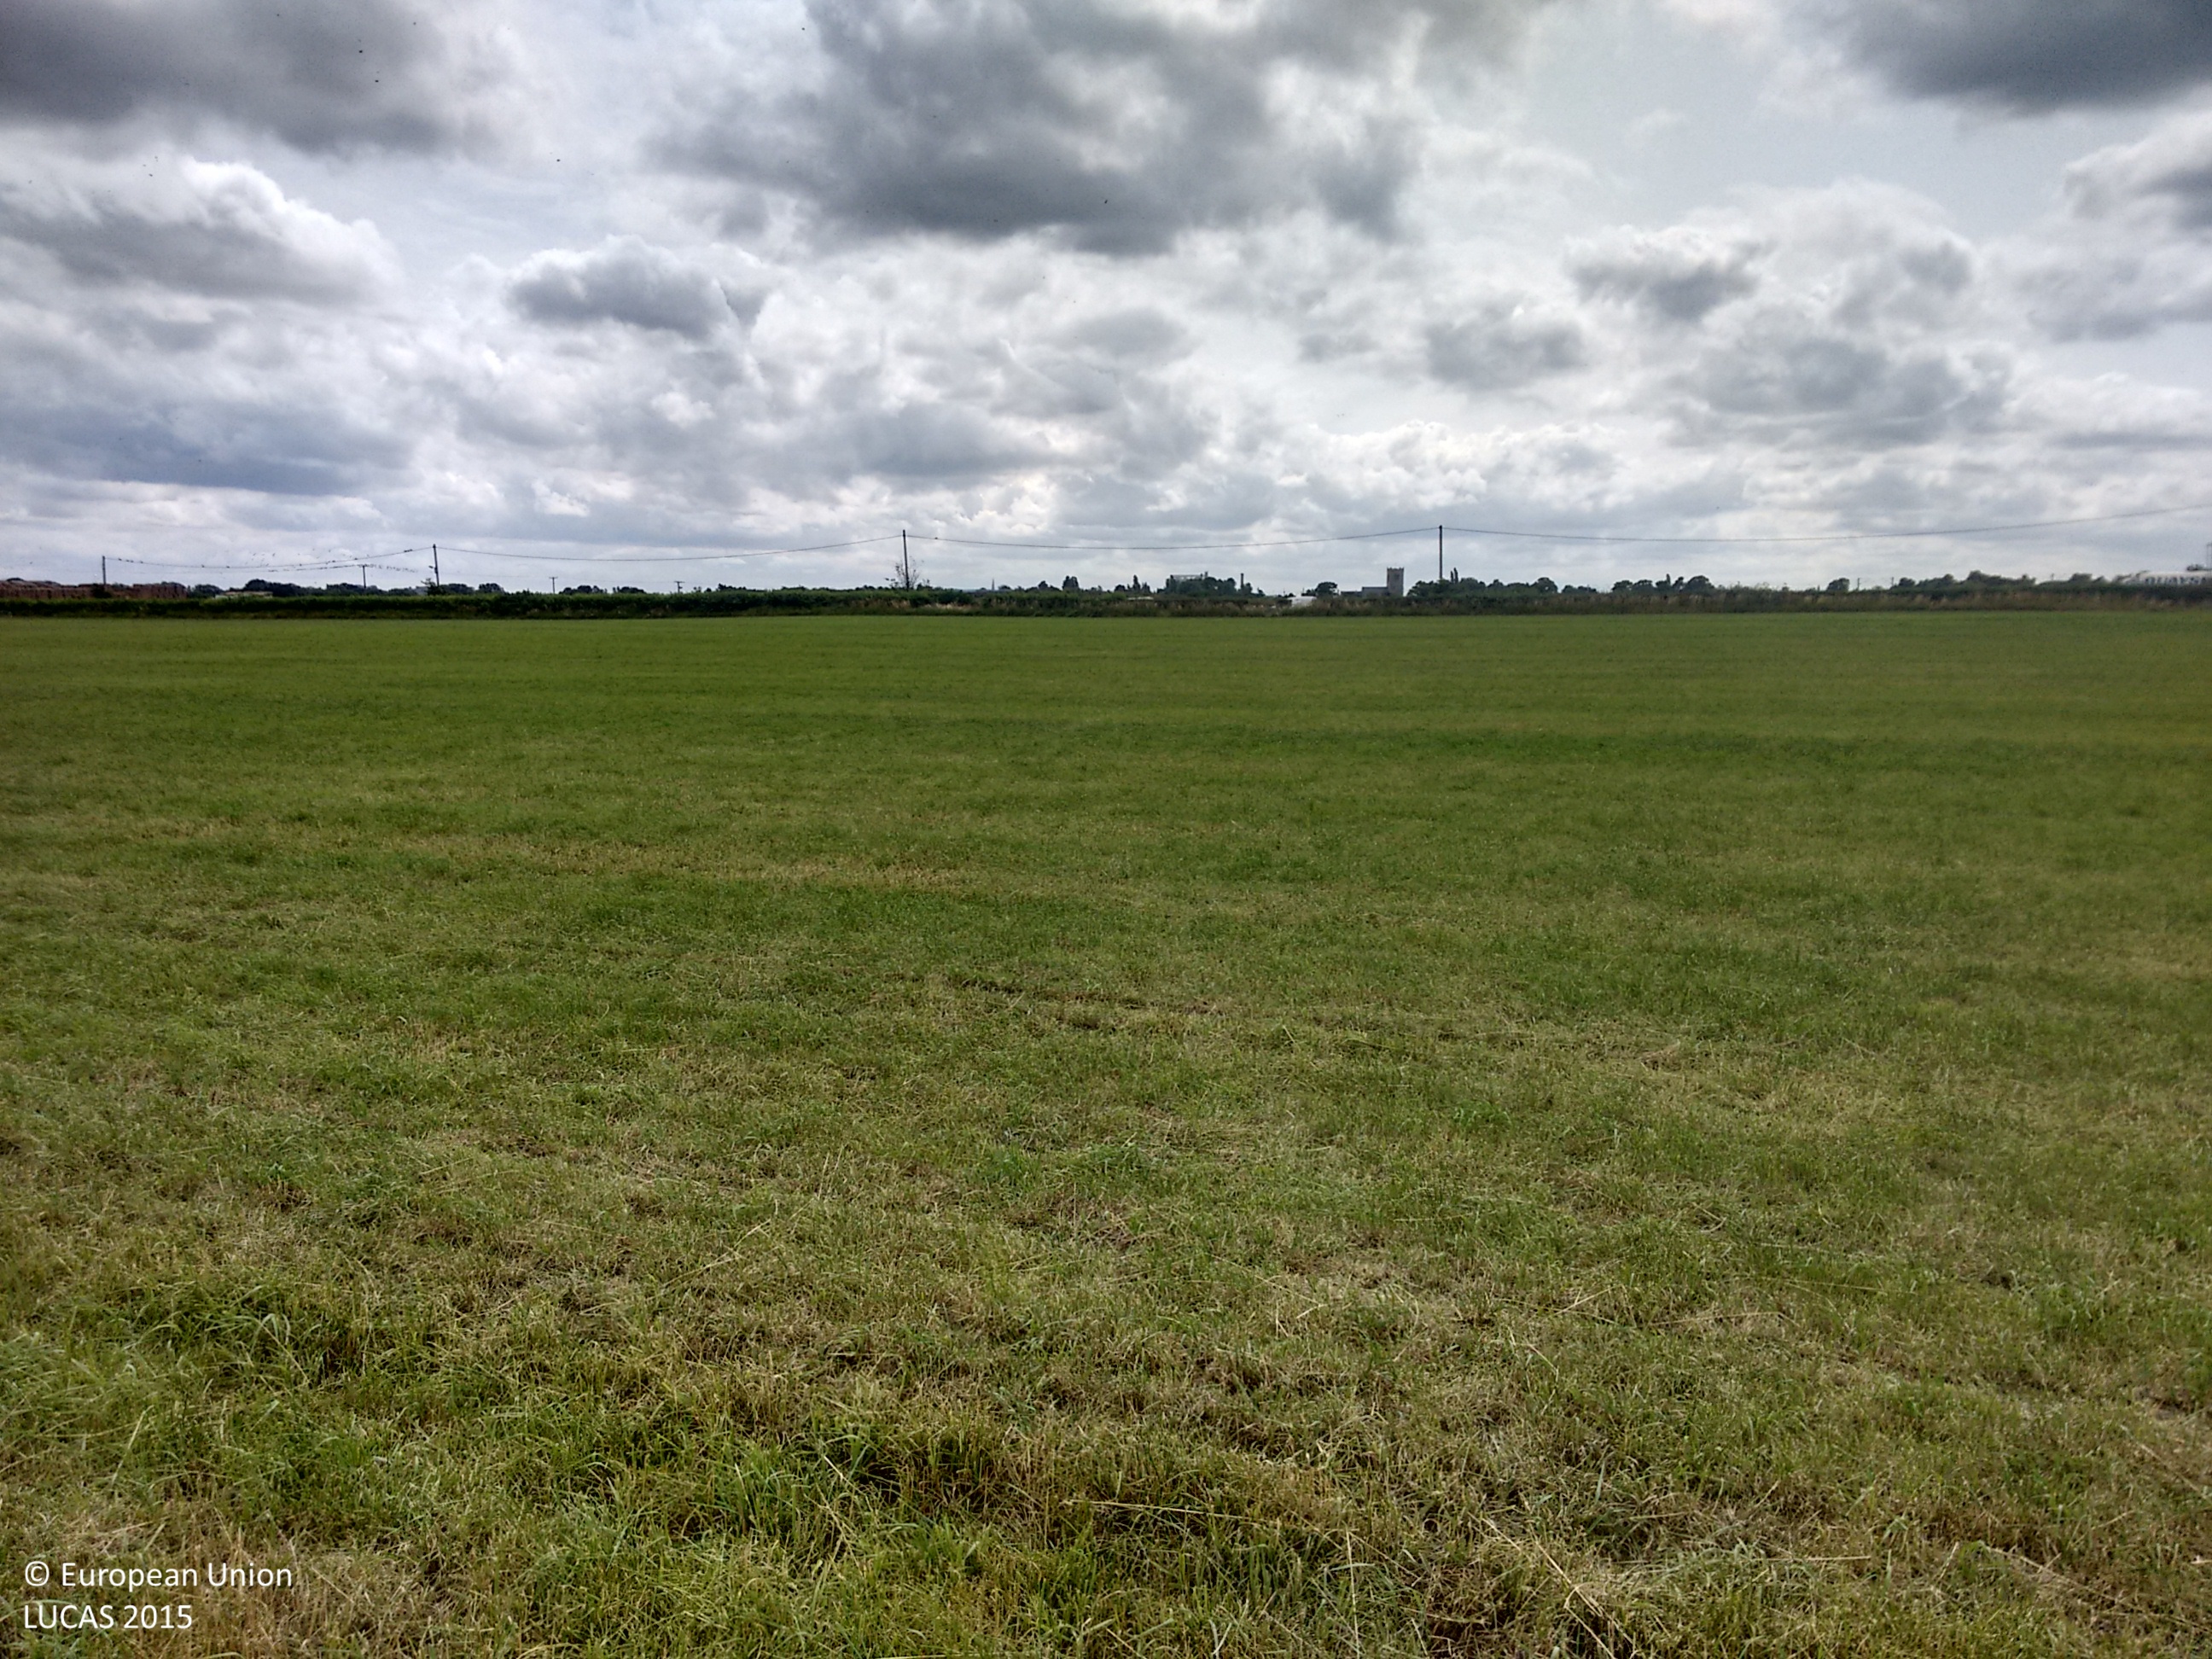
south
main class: Grassland
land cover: Grassland without tree/shrub cover
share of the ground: > 75 %
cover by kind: herbaceous plants 100 %
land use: Agriculture (excluding fallow land and kitchen gardens)
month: July
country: GB
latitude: 53.1158
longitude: -0.8136
